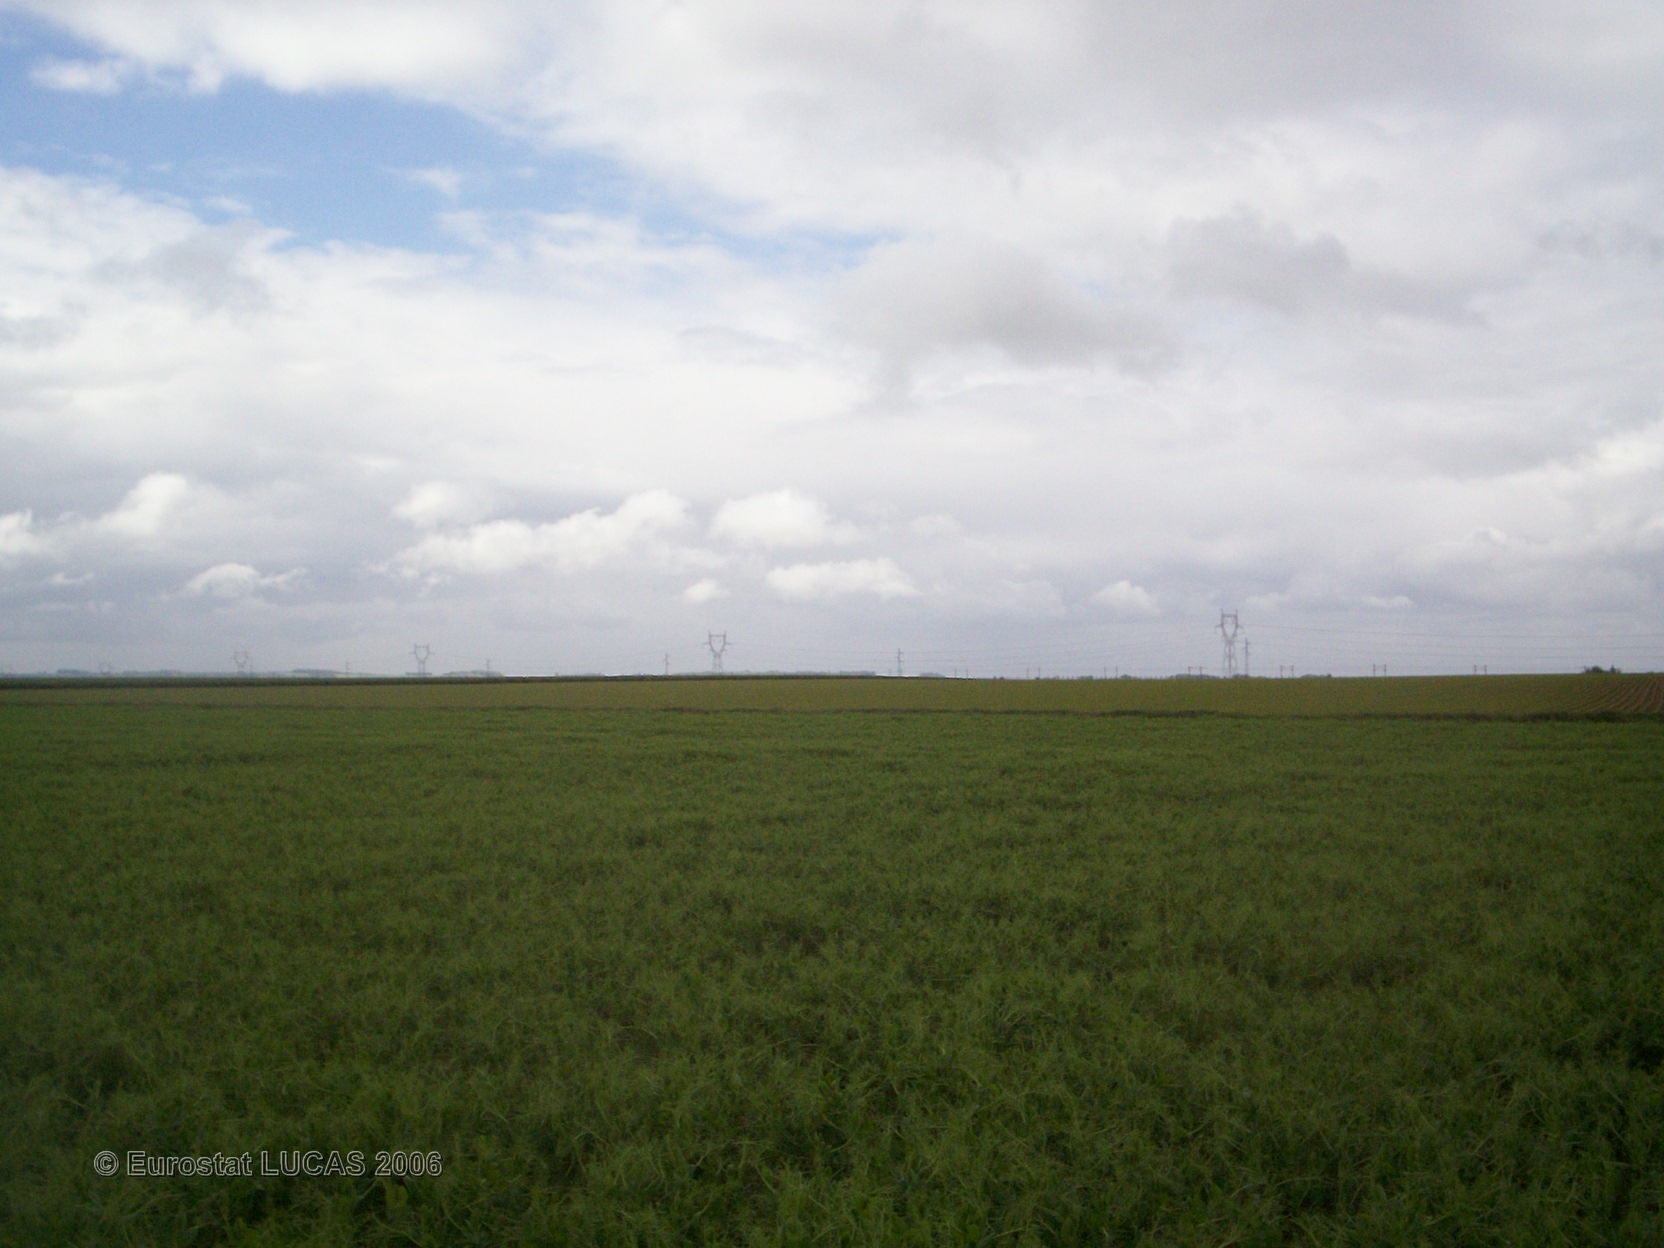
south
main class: Cropland
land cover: Dry pulses
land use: Agriculture (excluding fallow land and kitchen gardens)
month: May
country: FR
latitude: 49.2670
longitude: 2.7472
